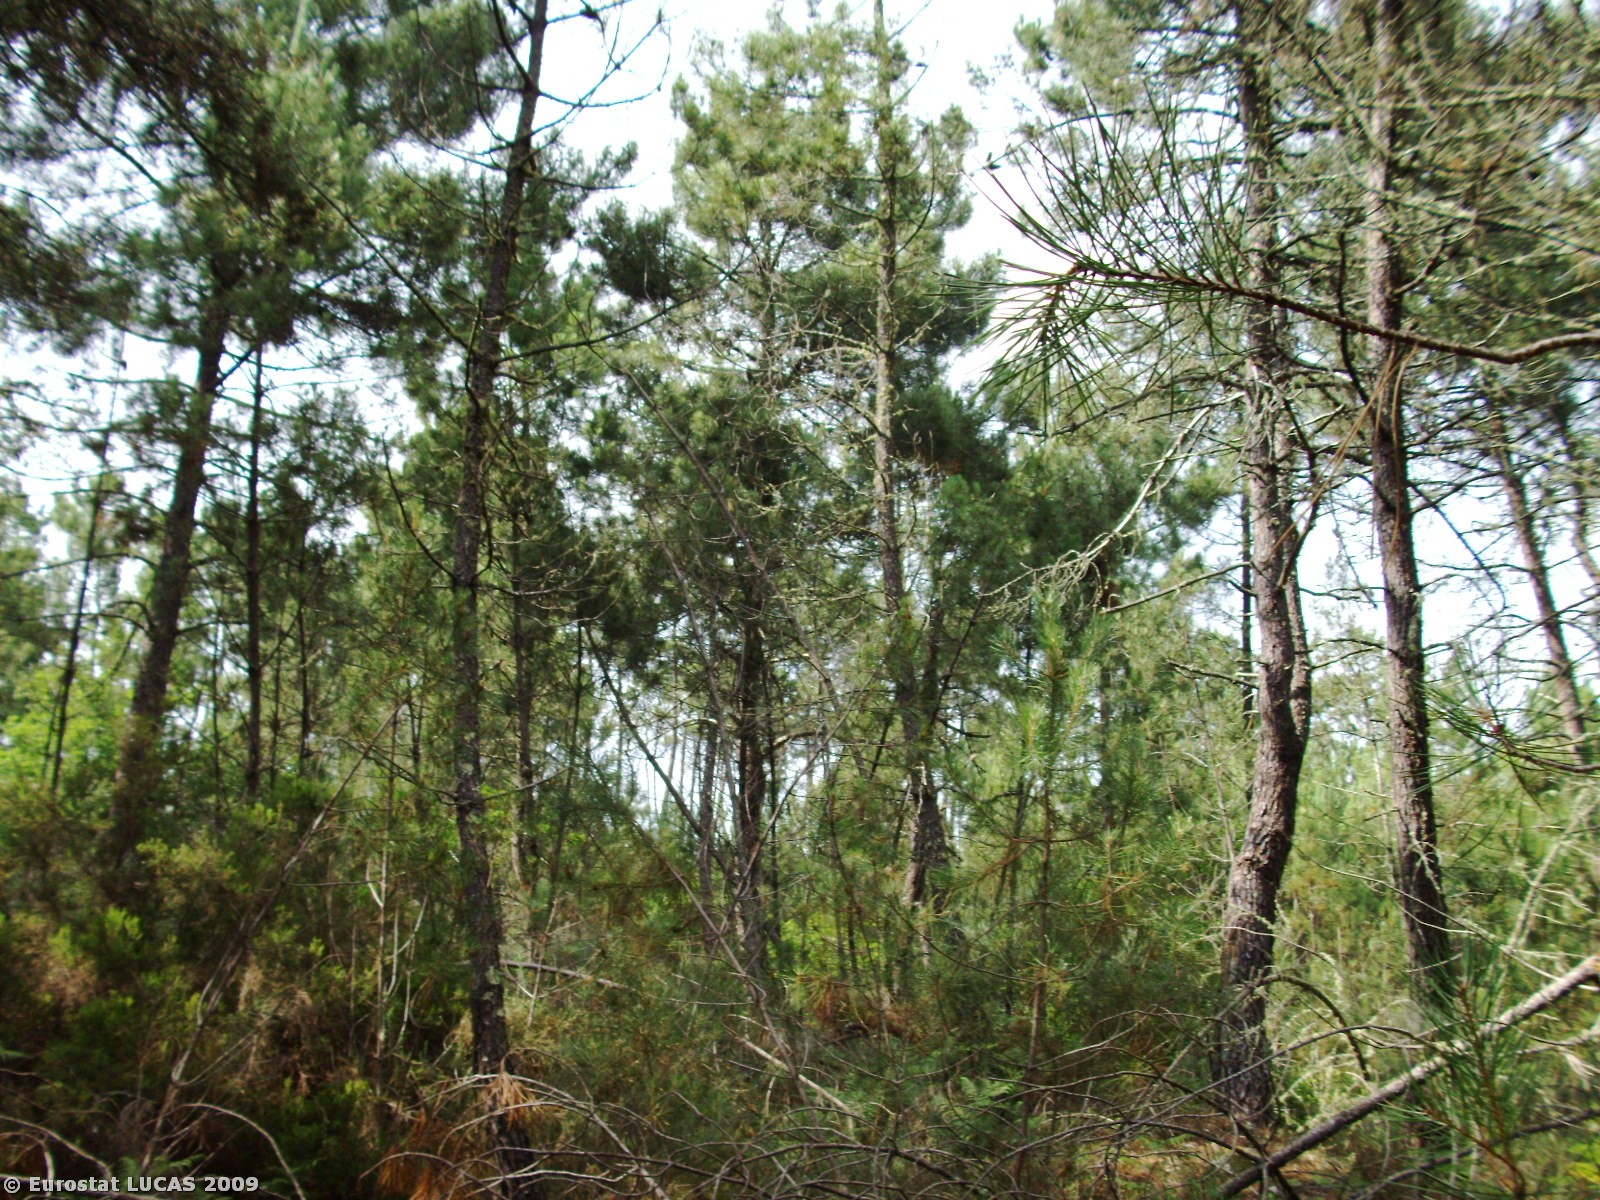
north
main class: Woodland
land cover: Coniferous woodland
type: coniferous forest of the mediterranean region
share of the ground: > 75 %
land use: Forestry
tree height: > 5 m
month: July
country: PT
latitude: 40.7294
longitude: -7.7027
